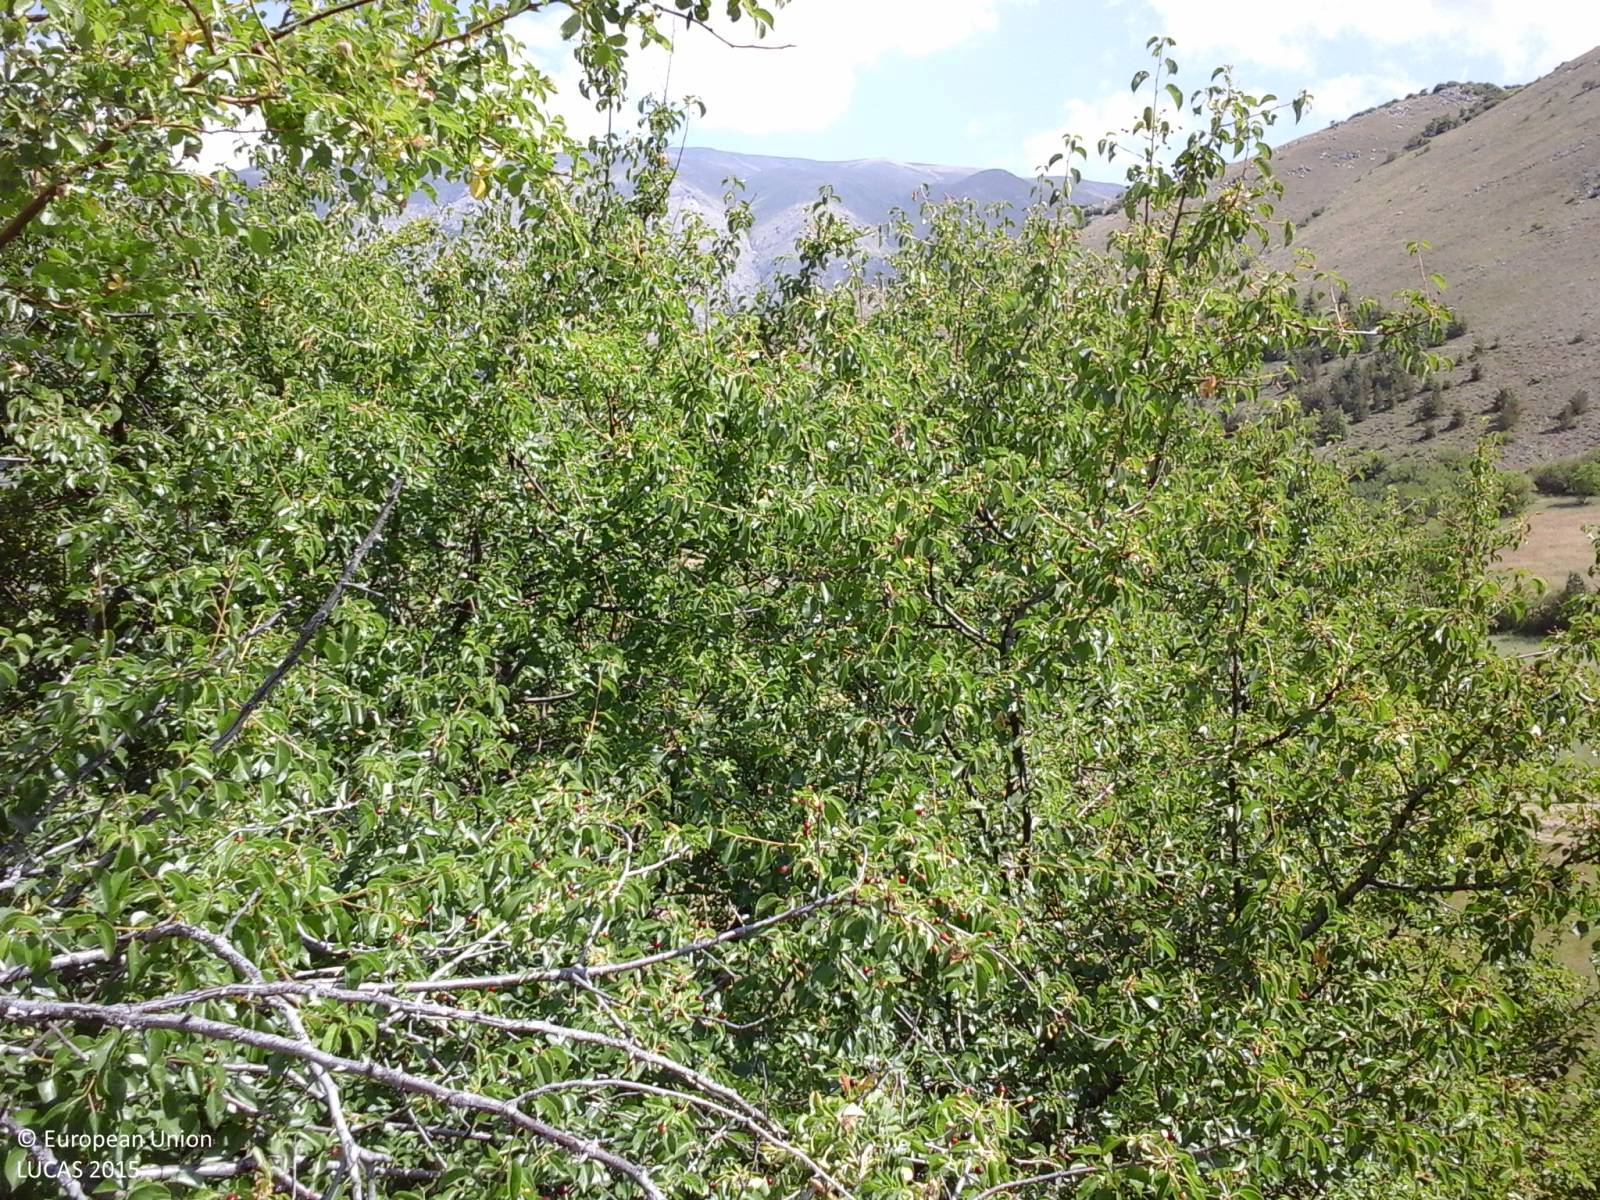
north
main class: Shrubland
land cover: Shrubland without tree cover
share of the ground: > 75 %
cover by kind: shrubs 100 %
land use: Semi-natural and natural areas not in use
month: June
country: IT
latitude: 42.0888
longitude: 13.4580
